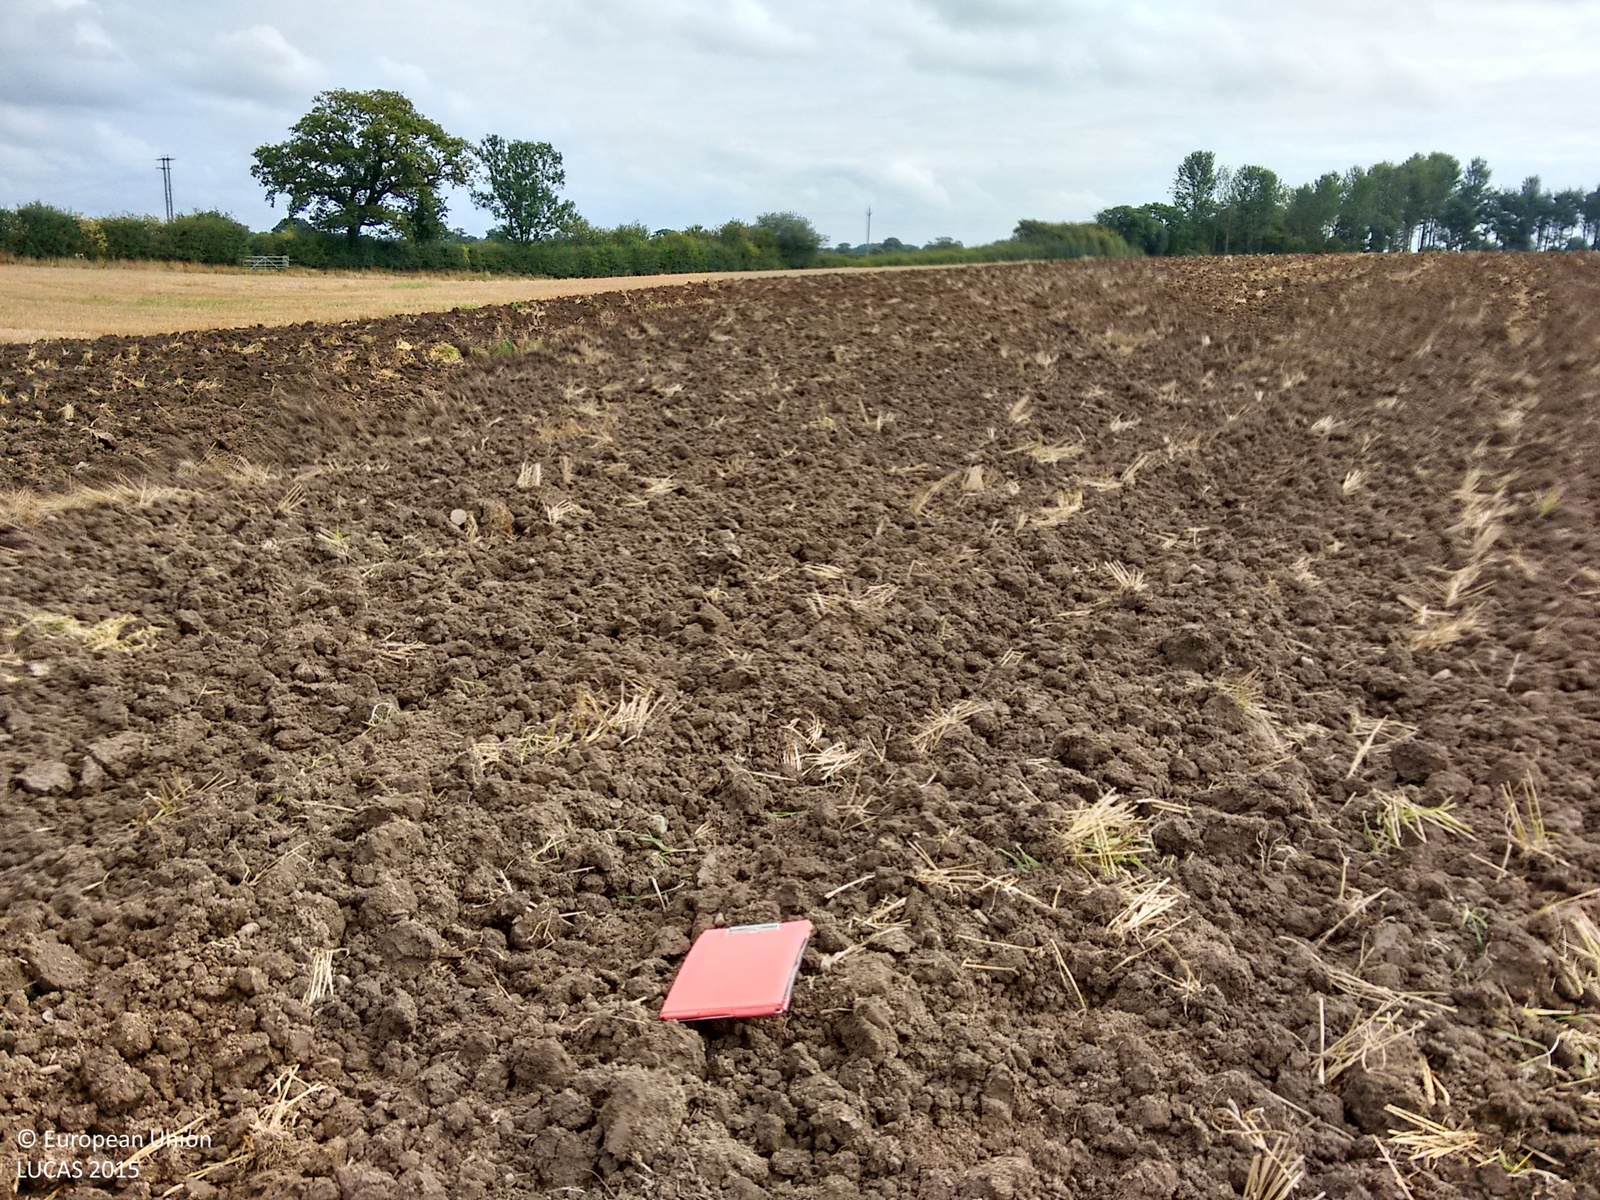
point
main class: Cropland
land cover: Barley
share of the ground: < 10 %
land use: Agriculture (excluding fallow land and kitchen gardens)
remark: Harvested field
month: September
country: GB
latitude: 52.8600
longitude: -3.0116
